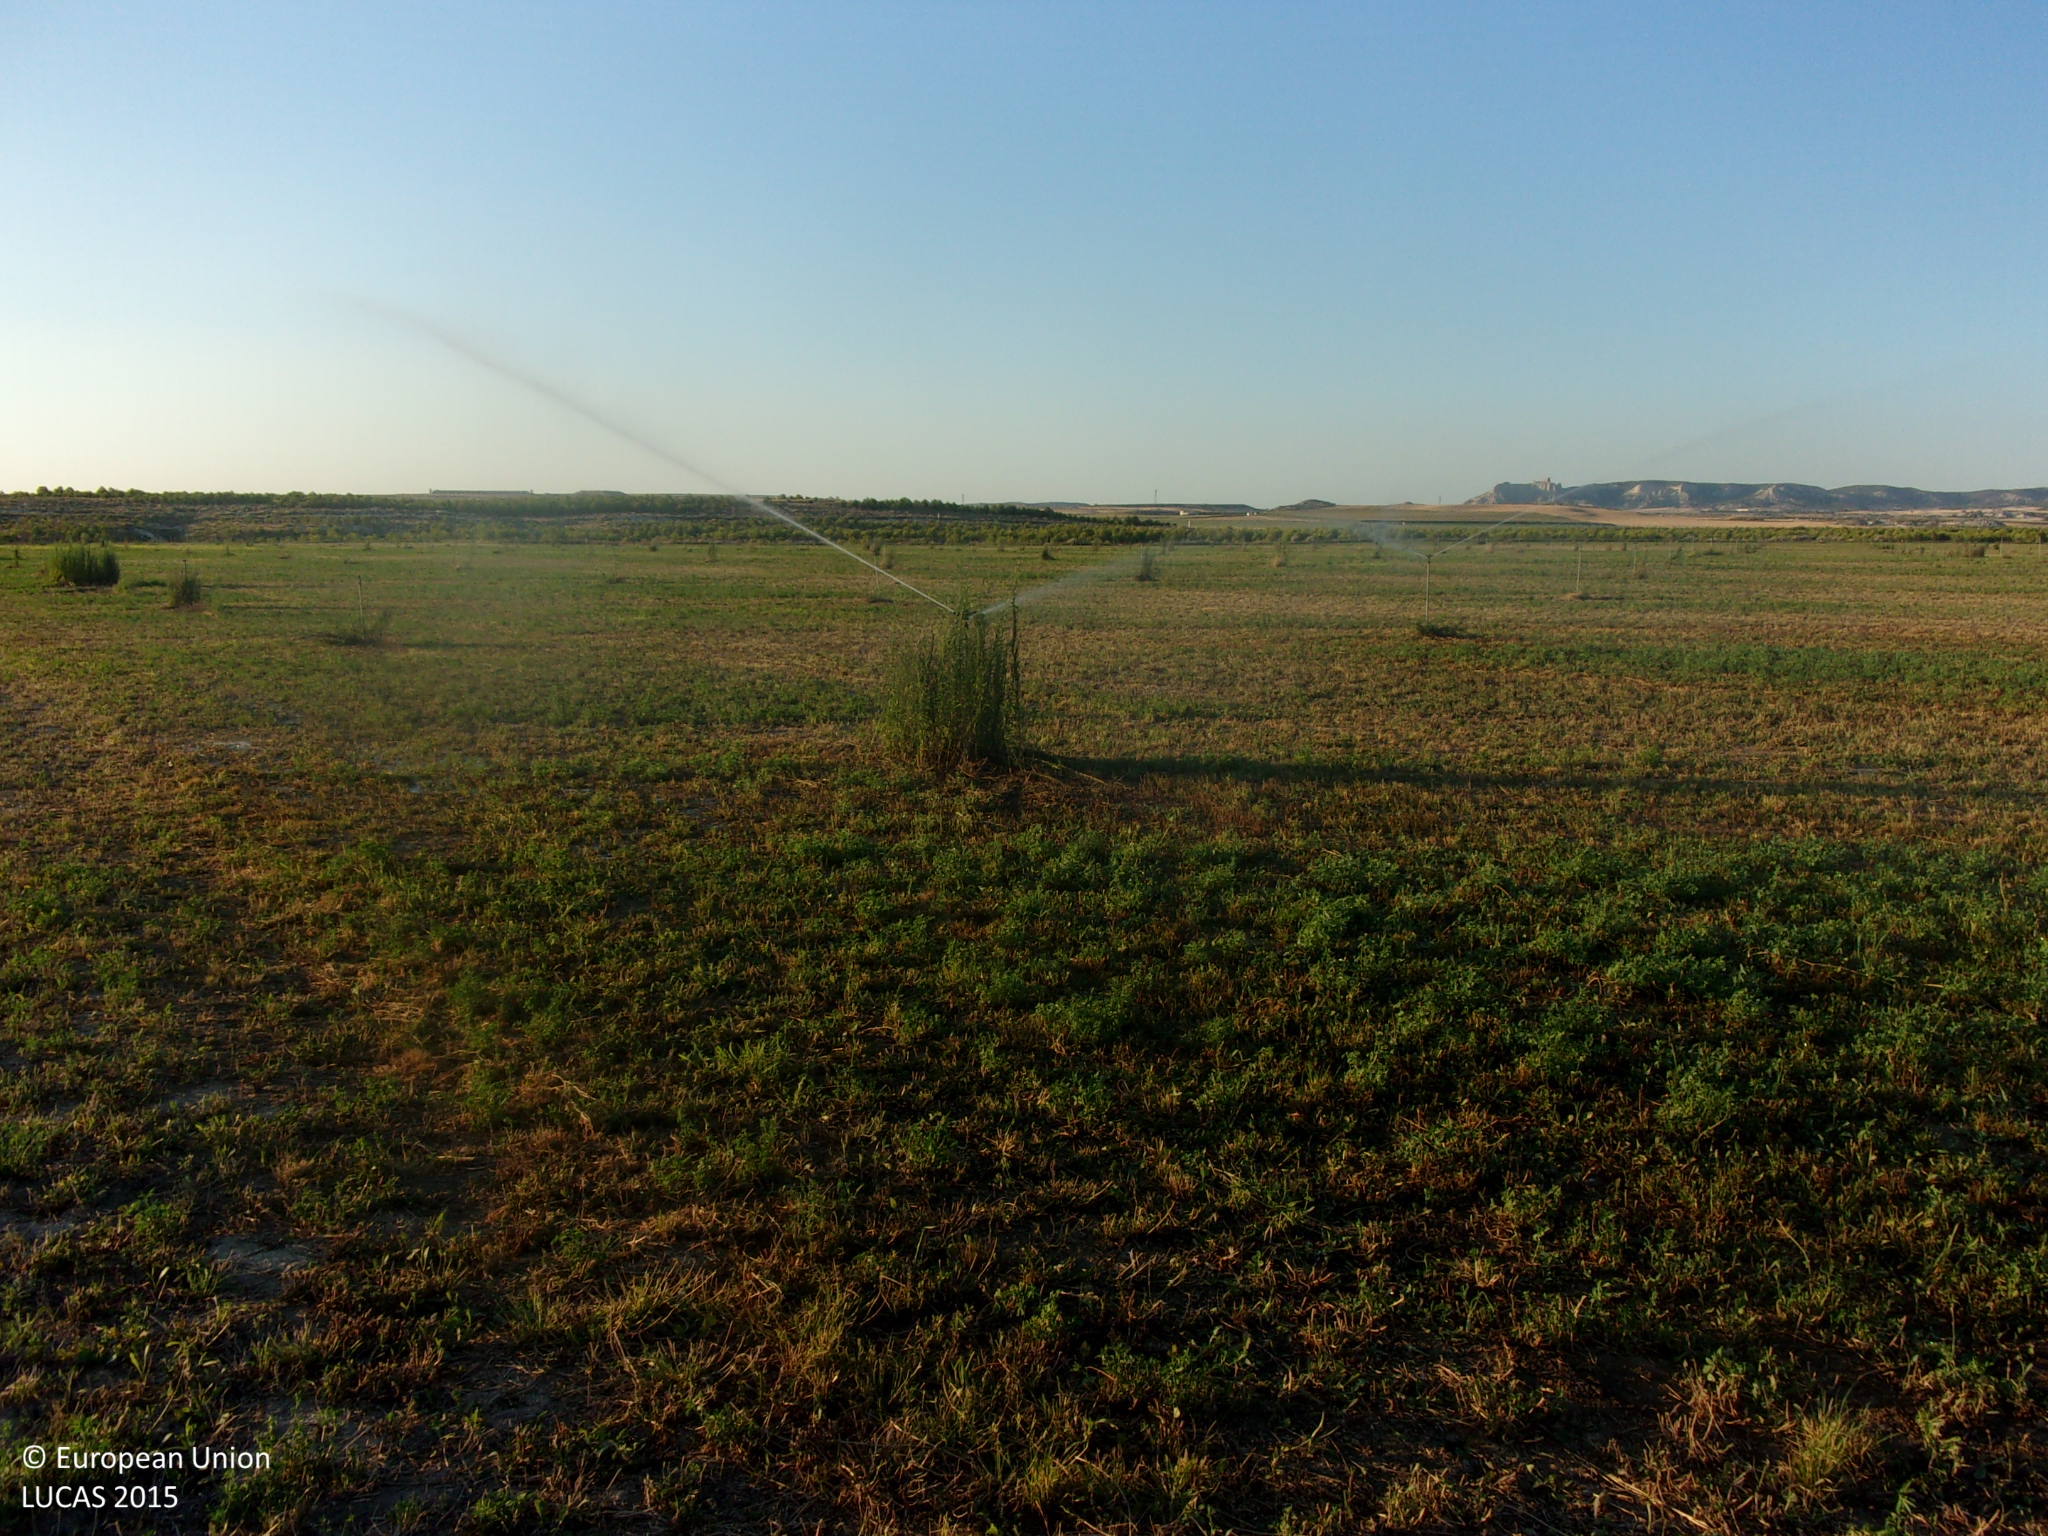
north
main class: Cropland
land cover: Lucerne
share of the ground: > 75 %
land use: Agriculture (excluding fallow land and kitchen gardens)
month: July
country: ES
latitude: 41.9700
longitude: -1.0919
